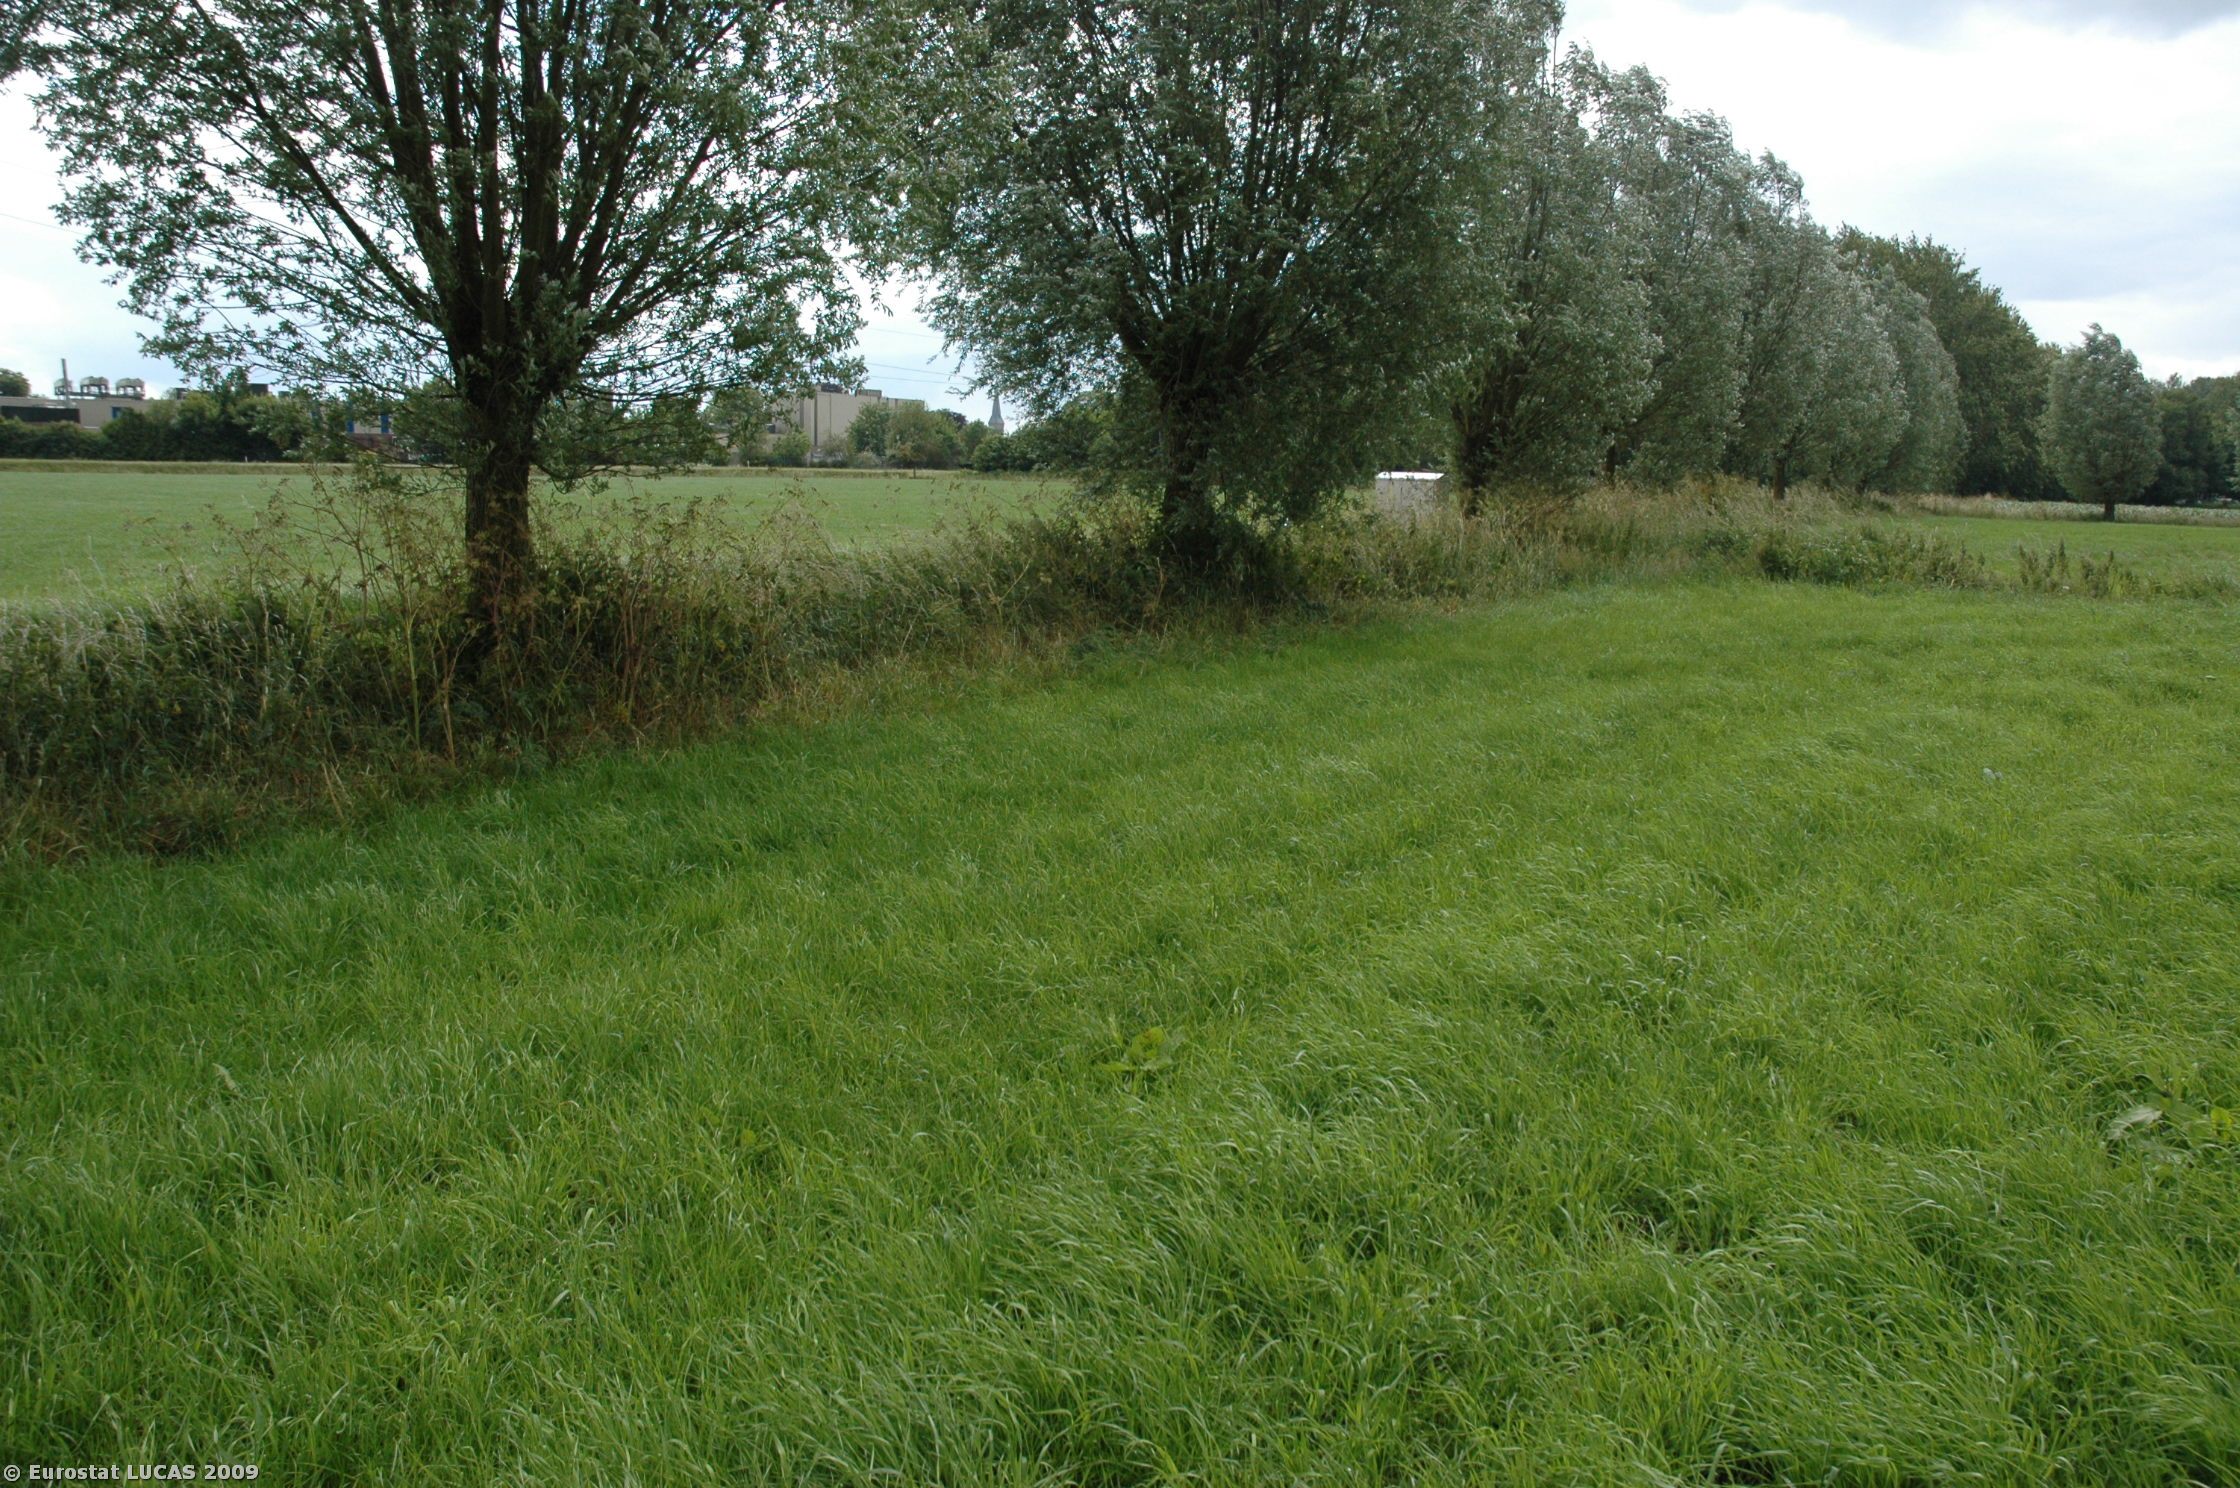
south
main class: Grassland
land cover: Grassland without tree/shrub cover
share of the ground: > 75 %
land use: Agriculture (excluding fallow land and kitchen gardens)
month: June
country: NL
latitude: 52.2411
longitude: 6.0891
